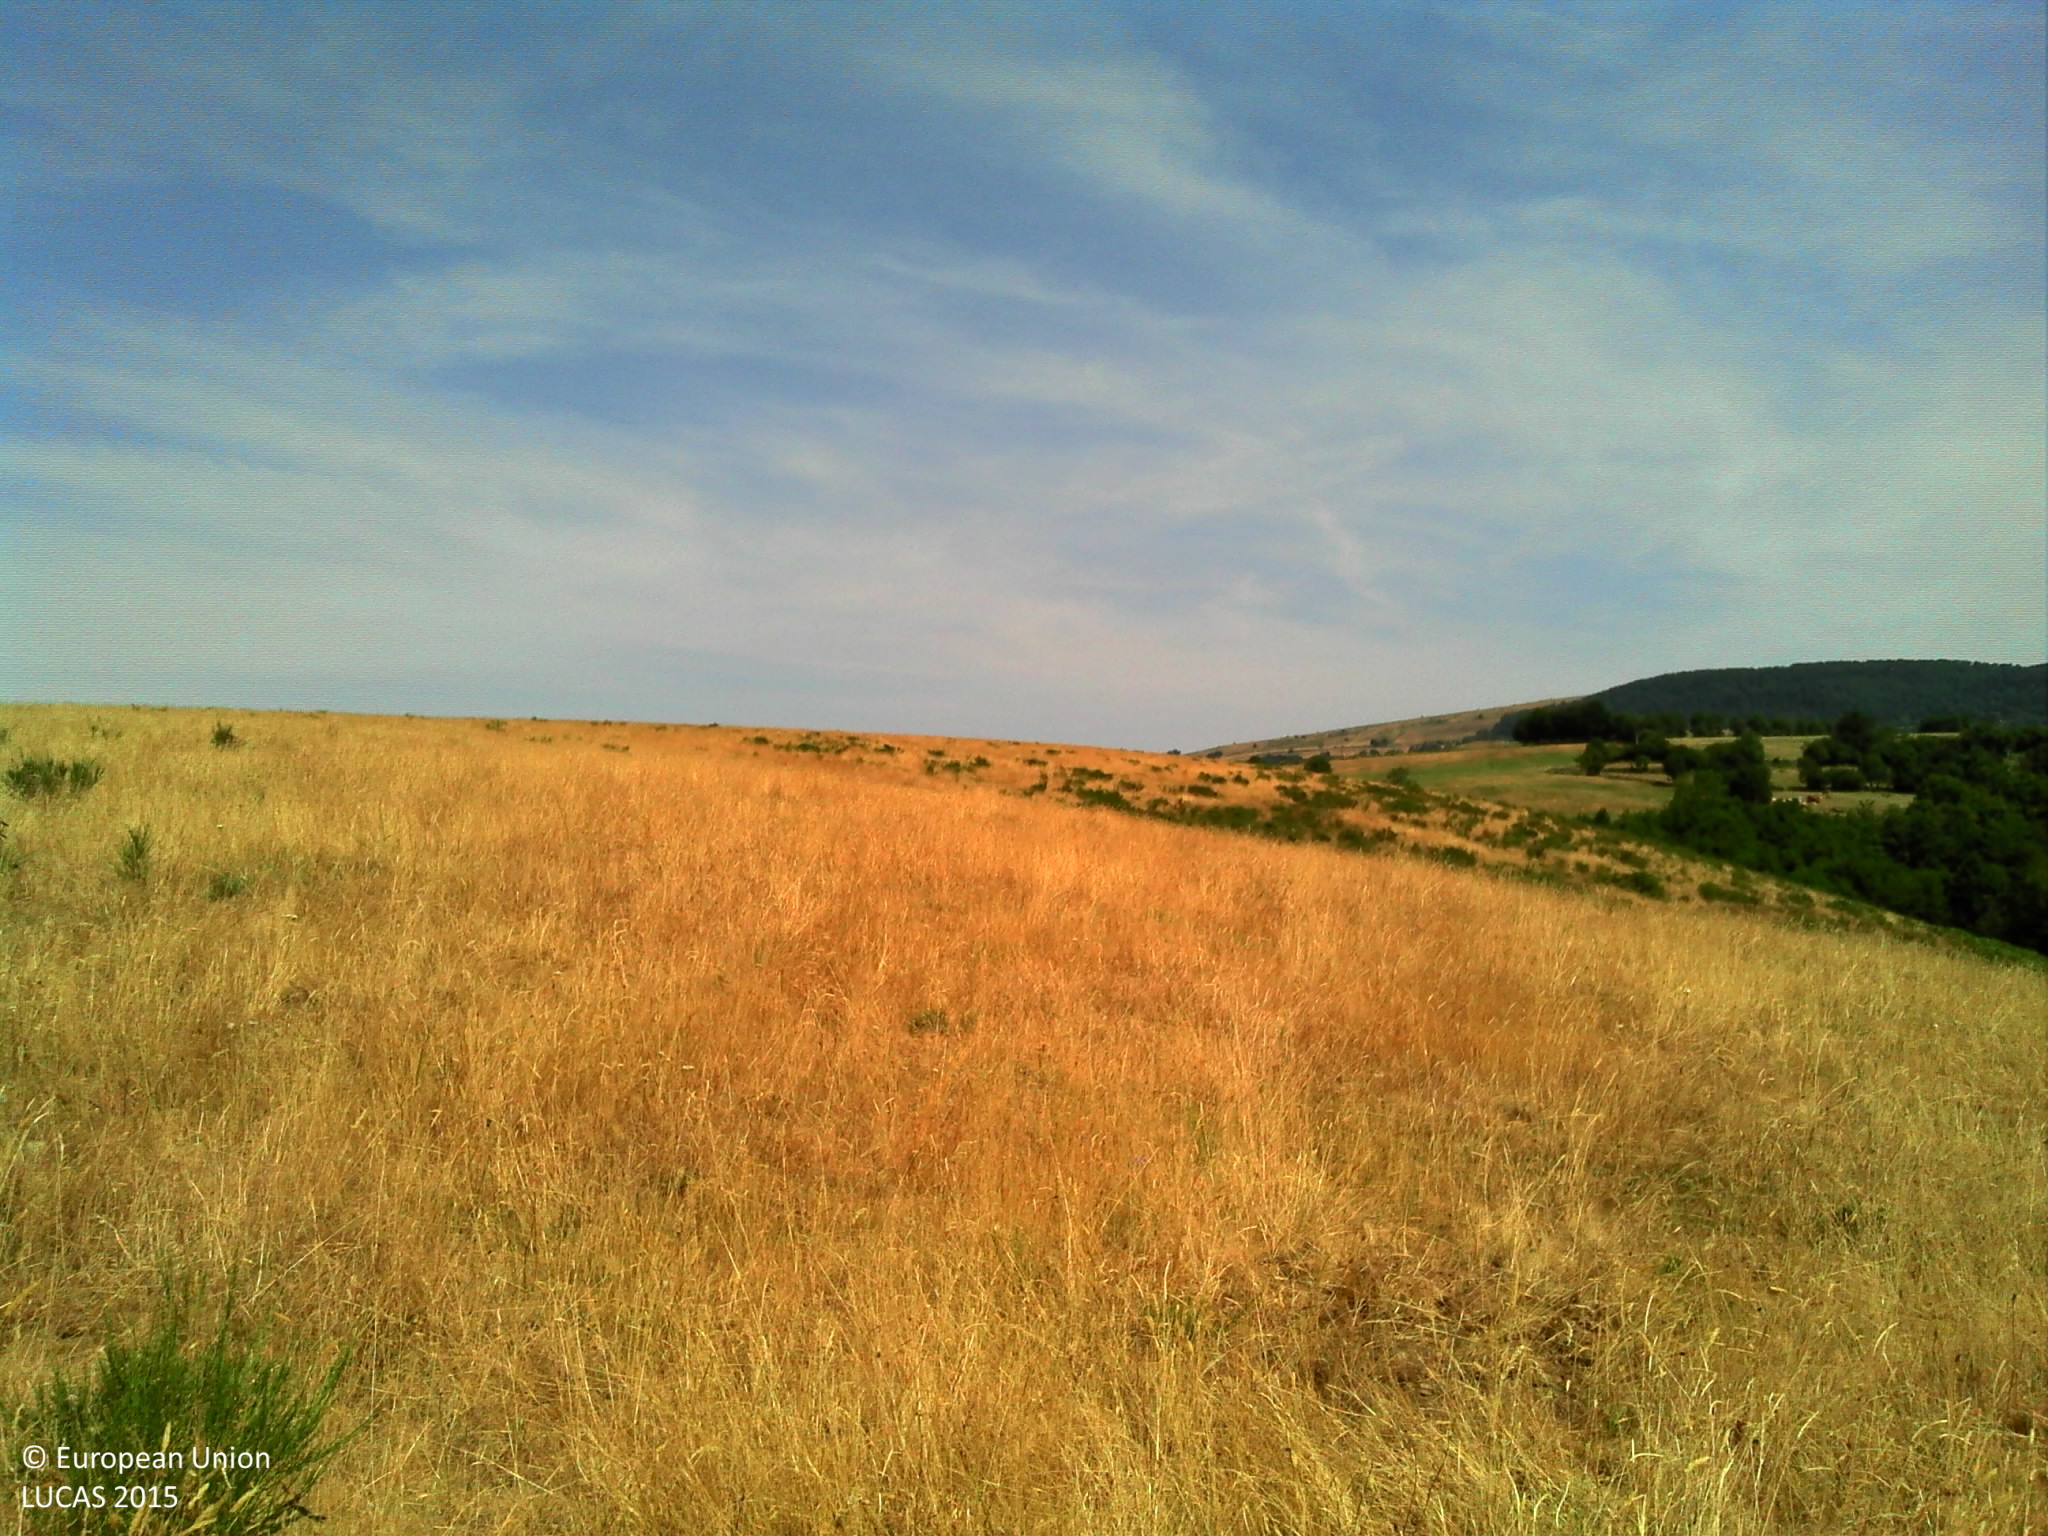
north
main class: Grassland
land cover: Grassland without tree/shrub cover
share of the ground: > 75 %
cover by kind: herbaceous plants 100 %
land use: Agriculture (excluding fallow land and kitchen gardens)
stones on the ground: 10 - 25 %
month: July
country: FR
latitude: 44.5462
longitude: 2.9677
